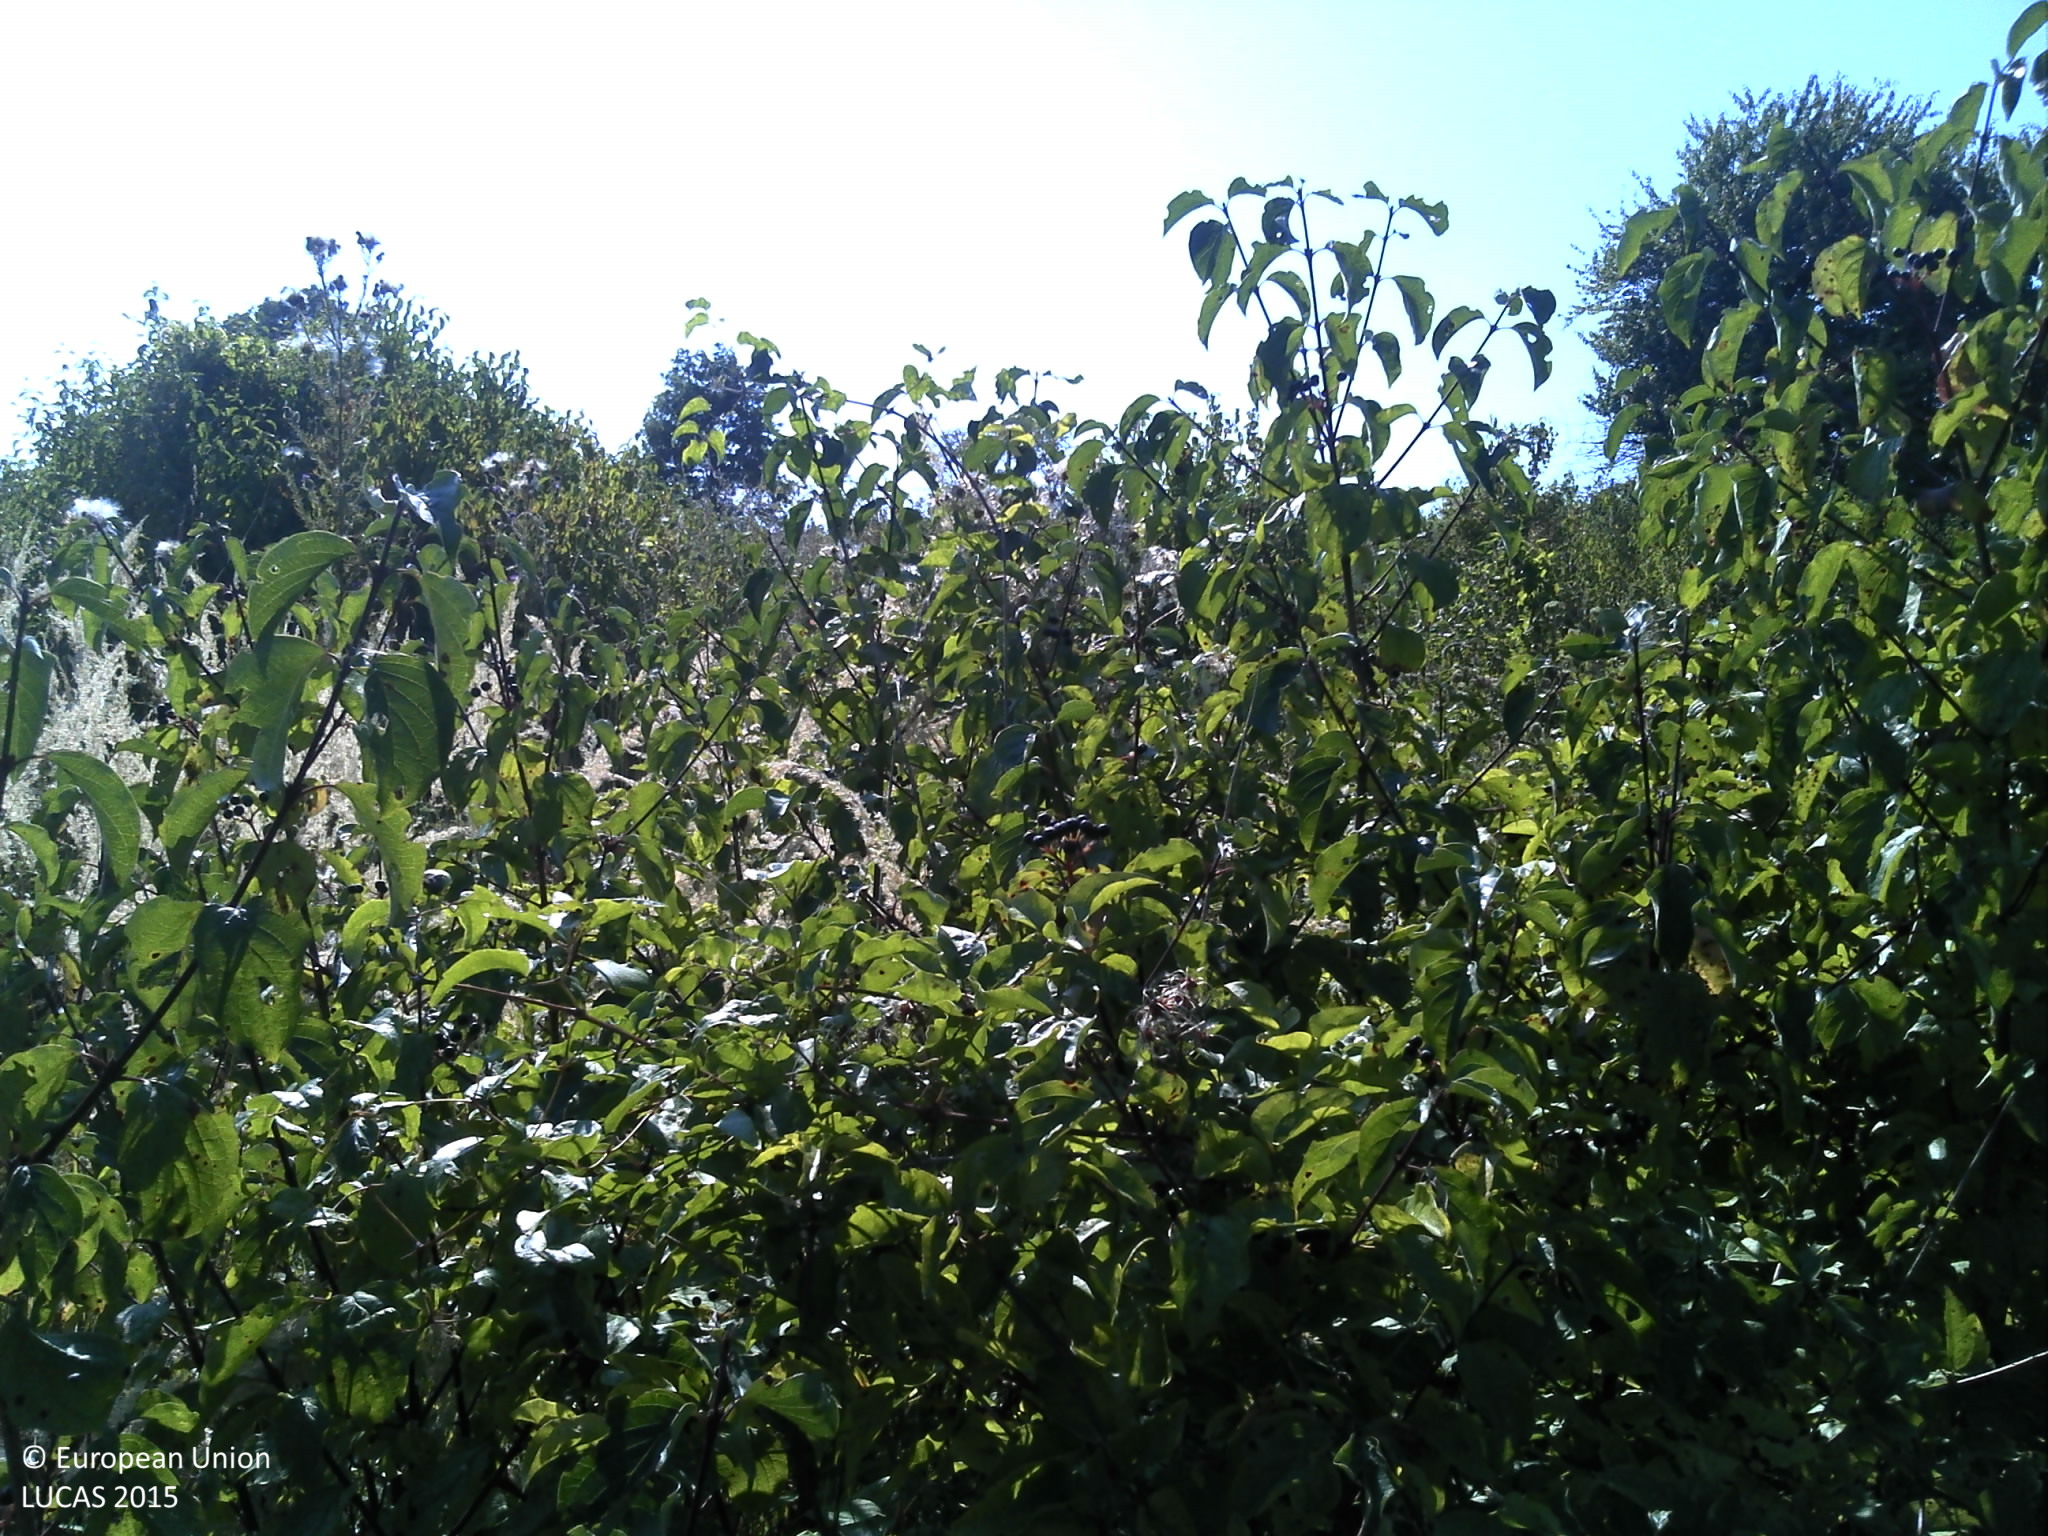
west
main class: Grassland
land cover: Spontaneously vegetated surfaces
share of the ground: > 75 %
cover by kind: herbaceous plants 100 %
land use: Semi-natural and natural areas not in use
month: August
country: HR
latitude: 45.1853
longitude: 16.3731
